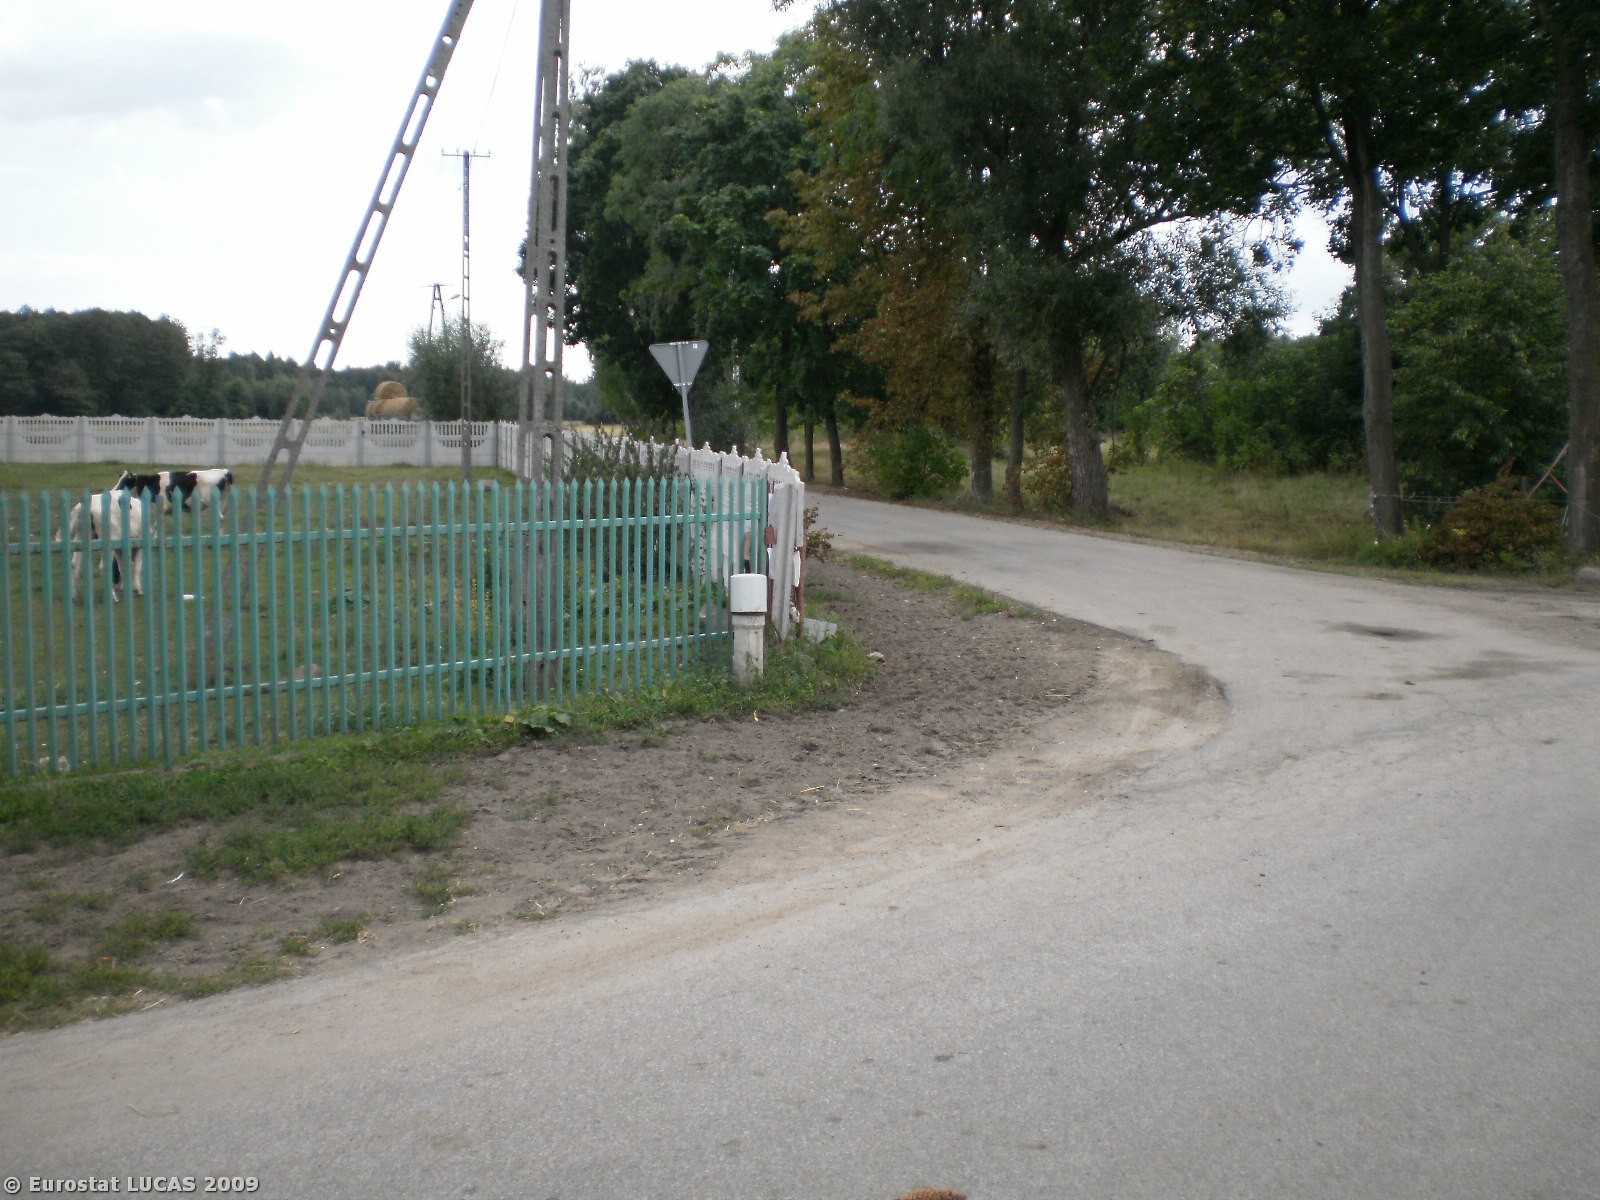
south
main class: Grassland
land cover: Grassland without tree/shrub cover
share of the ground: > 75 %
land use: Residential
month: August
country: PL
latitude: 52.9323
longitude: 21.7931
